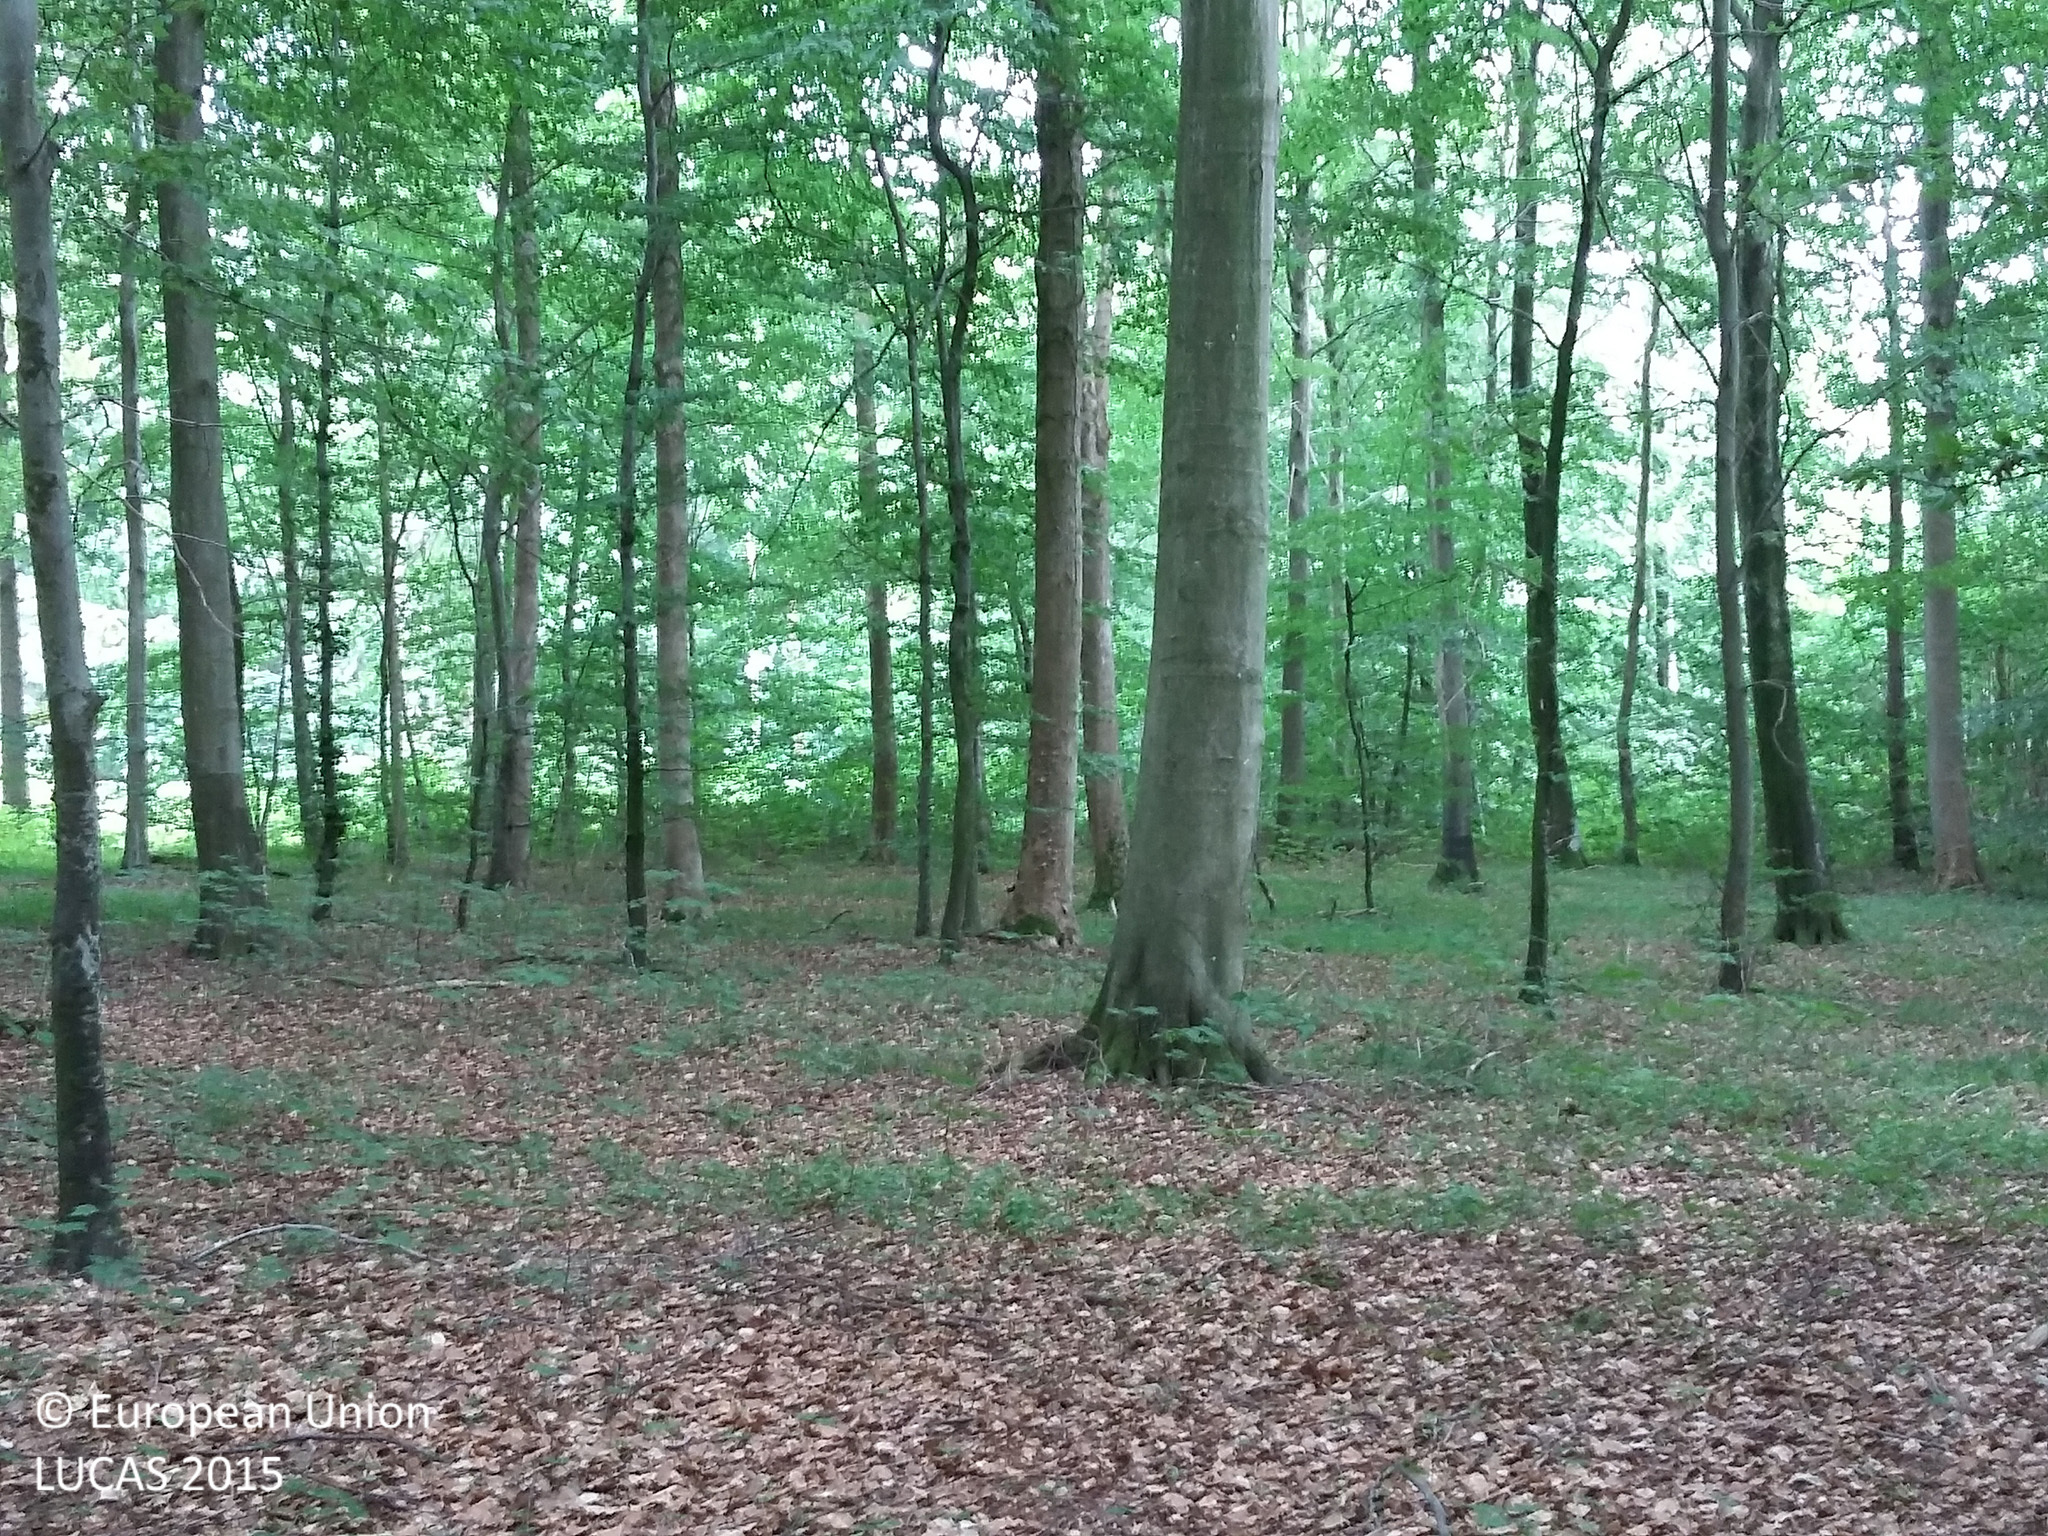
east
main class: Woodland
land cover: Broadleaved woodland
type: beech forest
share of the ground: > 75 %
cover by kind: broadleaved forest trees 80 %, herbaceous plants 10 %, unconsolidated bare surface 10 %
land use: Forestry
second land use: Amenities, museums, leisure
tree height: > 5 m
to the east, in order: Broadleaved woodland; Tracks; Broadleaved woodland; Ditches and canals; Broadleaved woodland; Ditches and canals; Broadleaved woodland
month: July
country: DK
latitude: 55.2765
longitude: 11.7774
